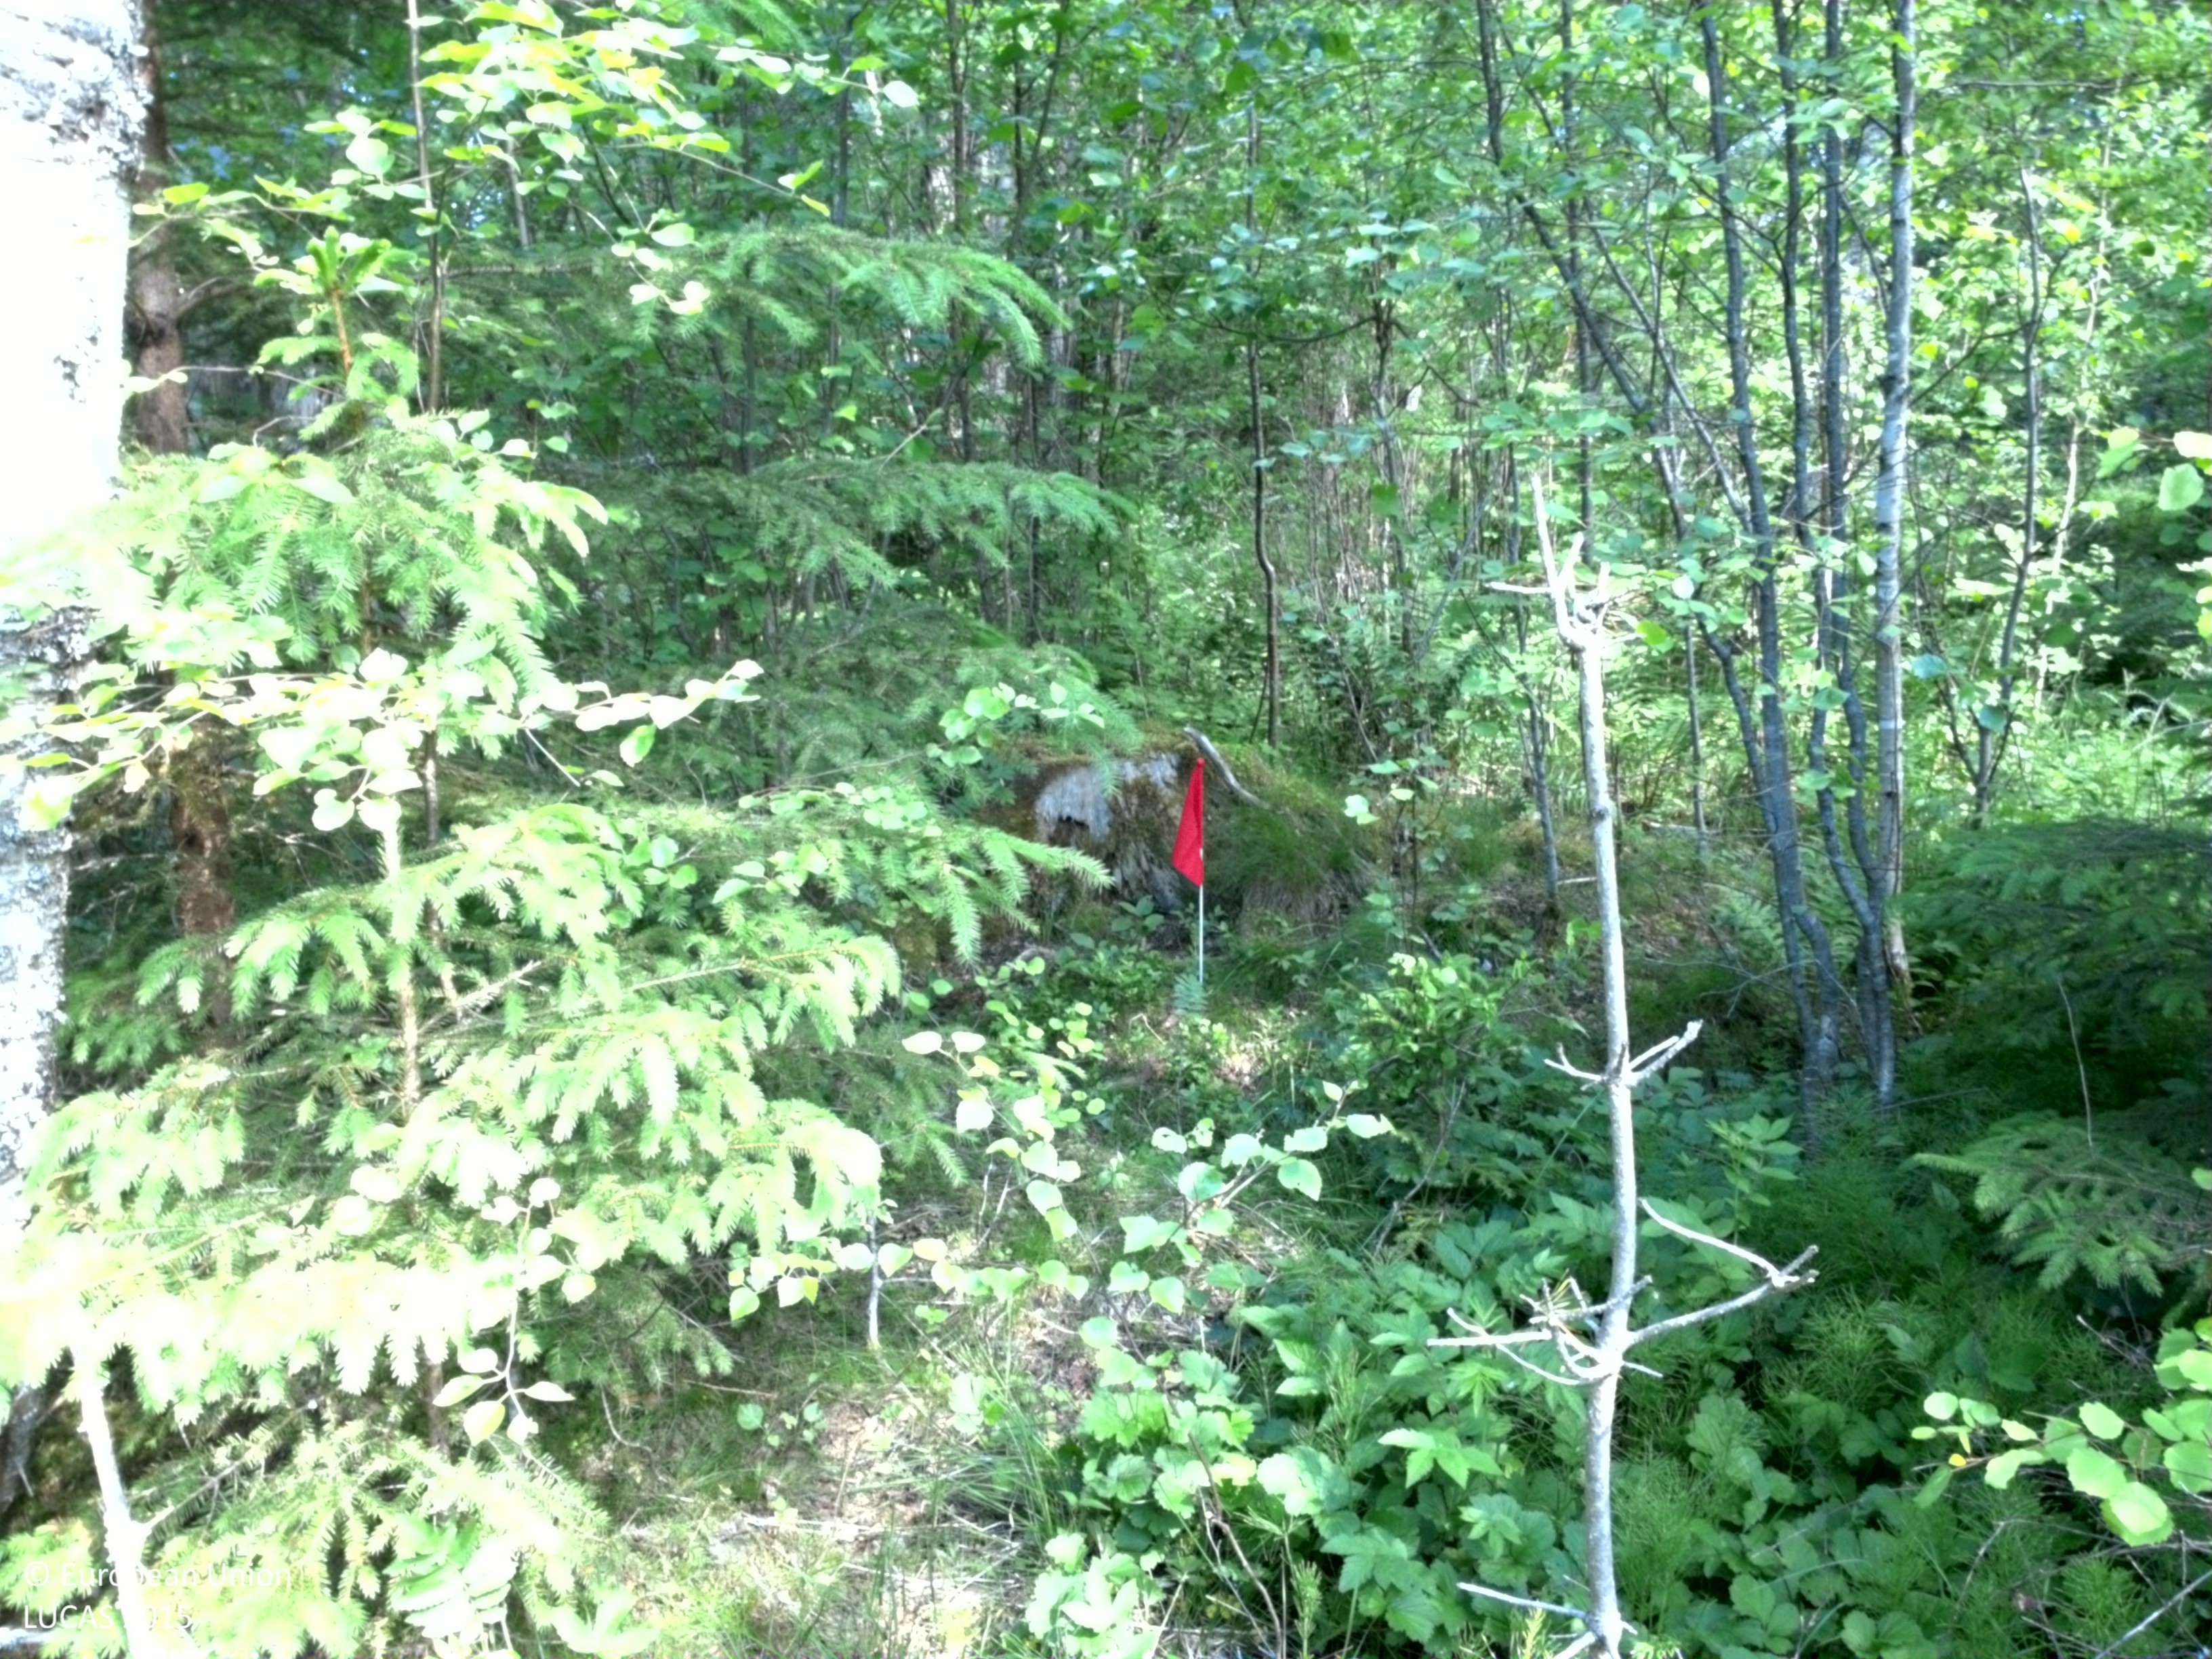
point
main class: Woodland
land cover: Broadleaved woodland
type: boreal forest
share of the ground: > 75 %
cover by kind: broadleaved forest trees 80 %, coniferous forest trees 10 %, herbaceous plants 10 %
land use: Forestry
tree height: > 5 m
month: June
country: SE
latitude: 58.6311
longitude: 14.4885
